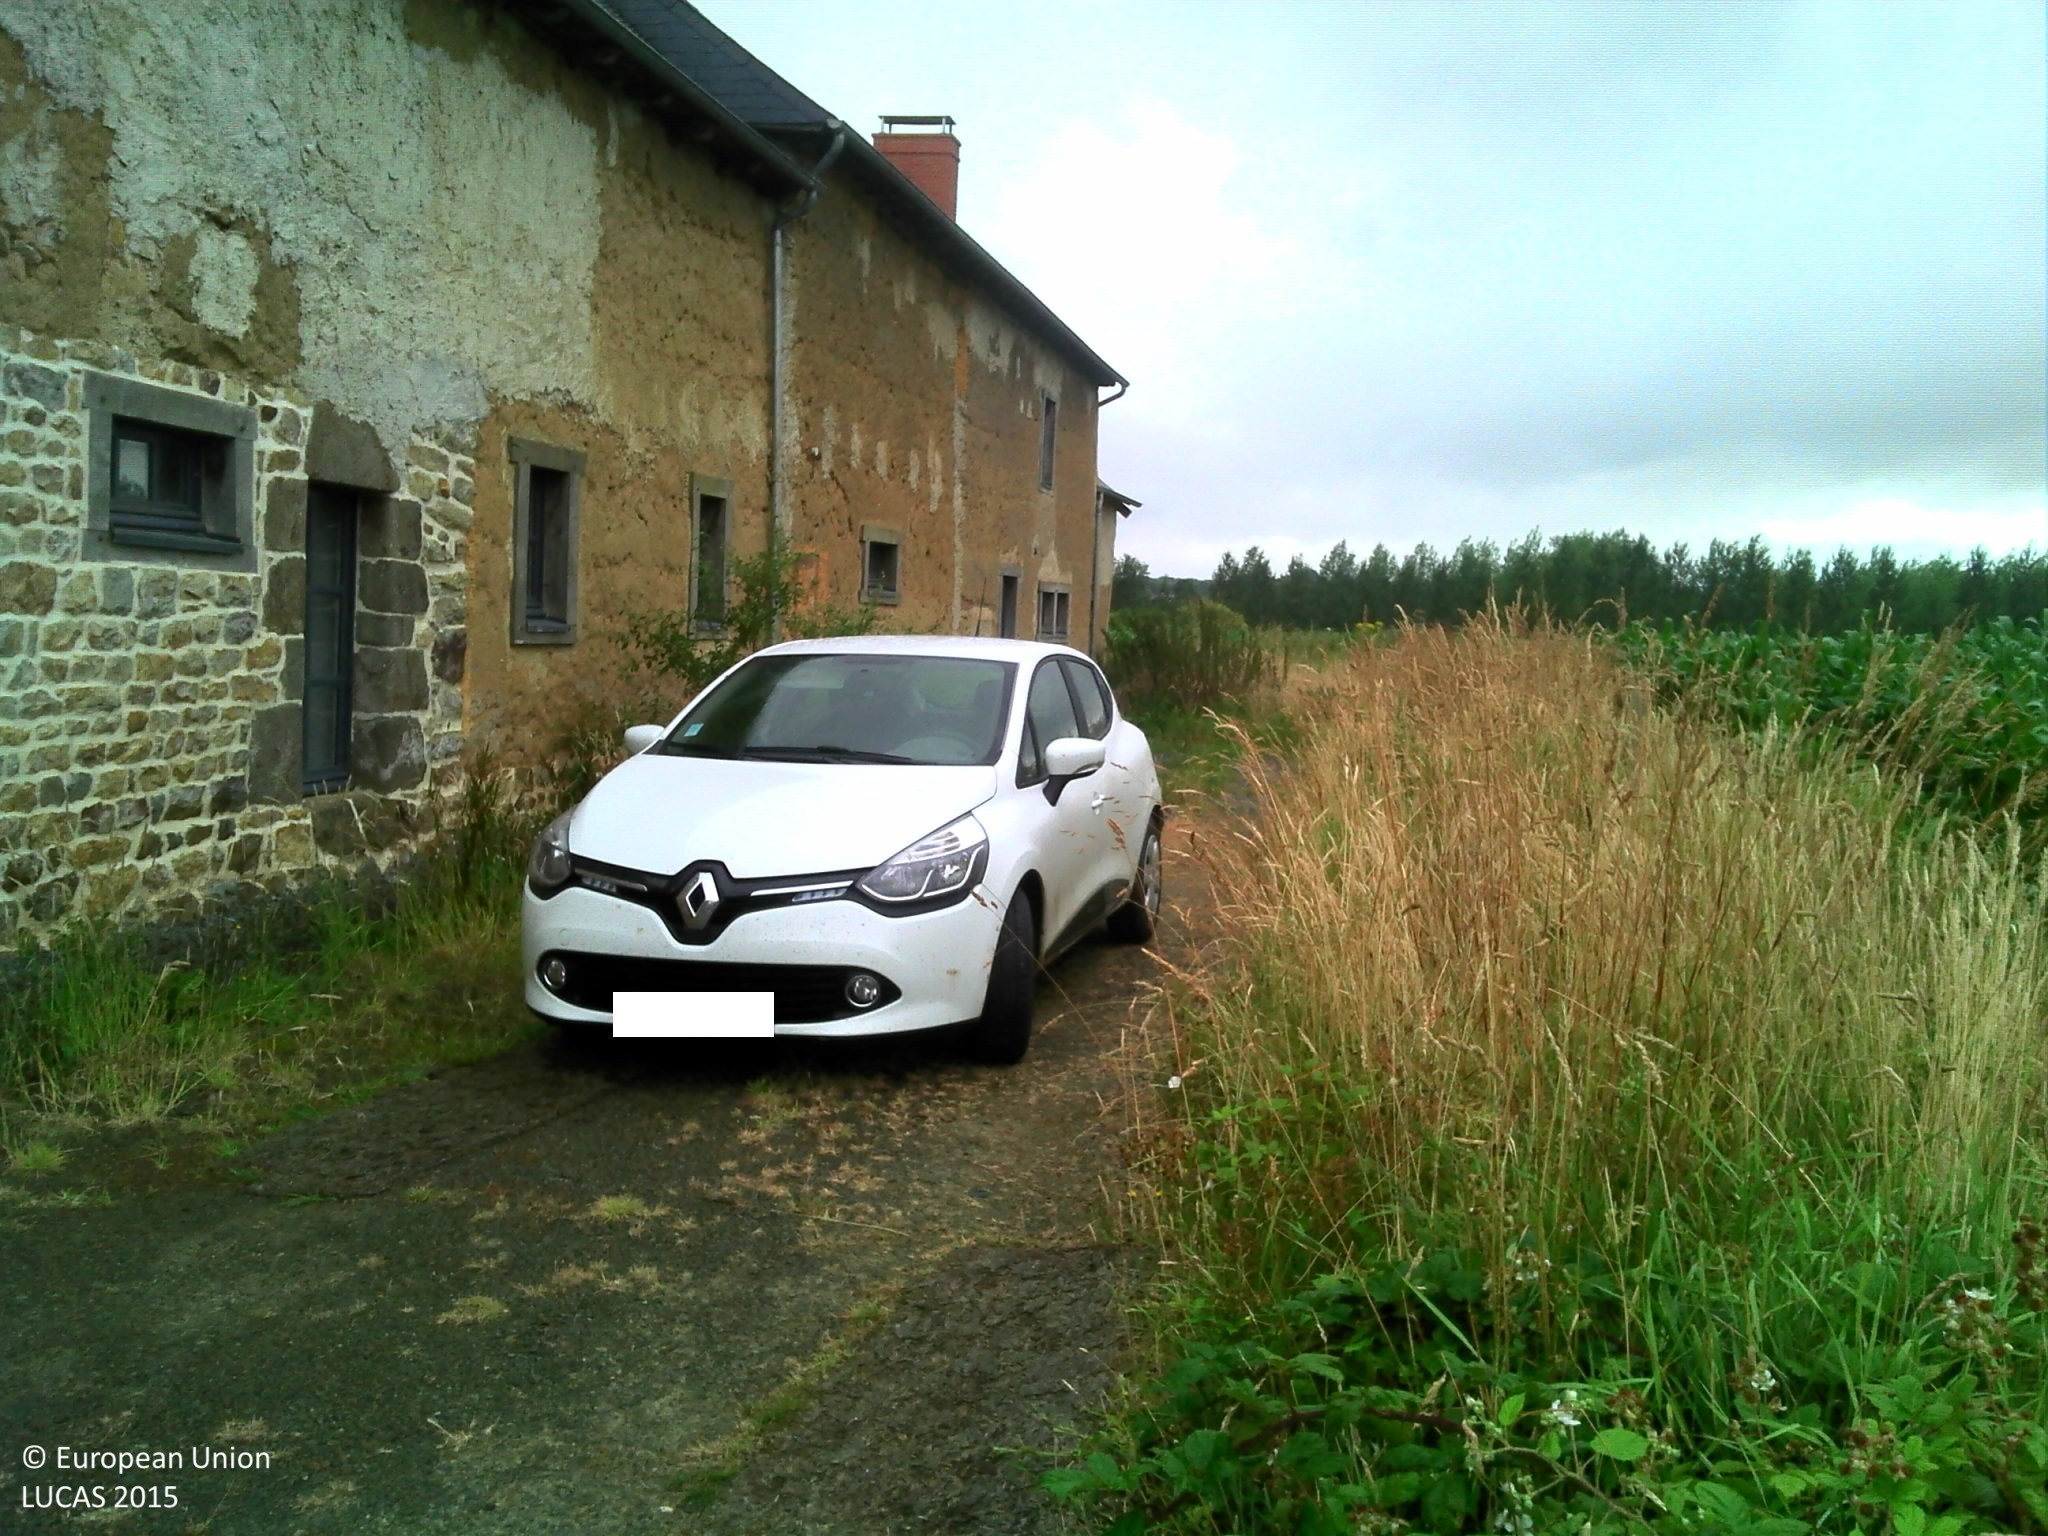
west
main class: Grassland
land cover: Grassland without tree/shrub cover
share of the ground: > 75 %
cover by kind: herbaceous plants 100 %
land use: Agriculture (excluding fallow land and kitchen gardens)
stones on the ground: 10 - 25 %
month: July
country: FR
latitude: 48.2623
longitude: -1.9472
